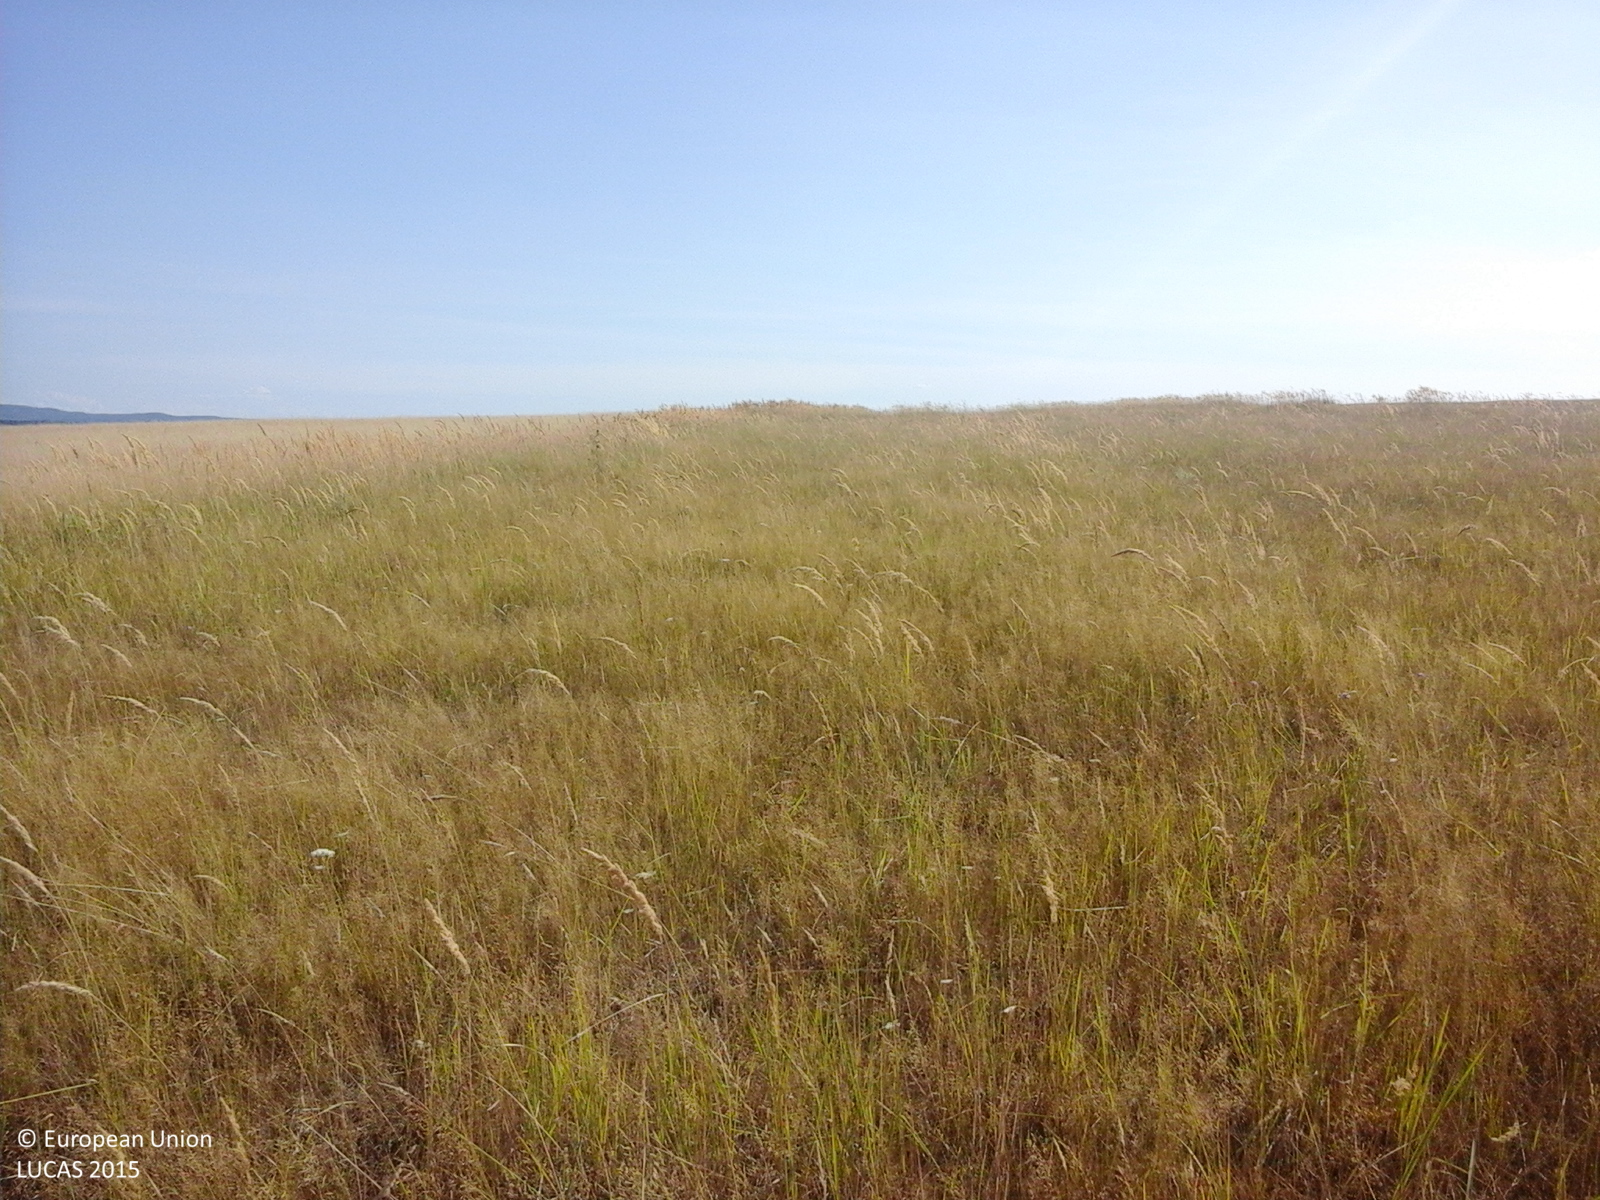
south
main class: Grassland
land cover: Grassland without tree/shrub cover
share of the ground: > 75 %
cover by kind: herbaceous plants 100 %
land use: Agriculture (excluding fallow land and kitchen gardens)
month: August
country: RO
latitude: 45.3912
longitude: 21.5923
